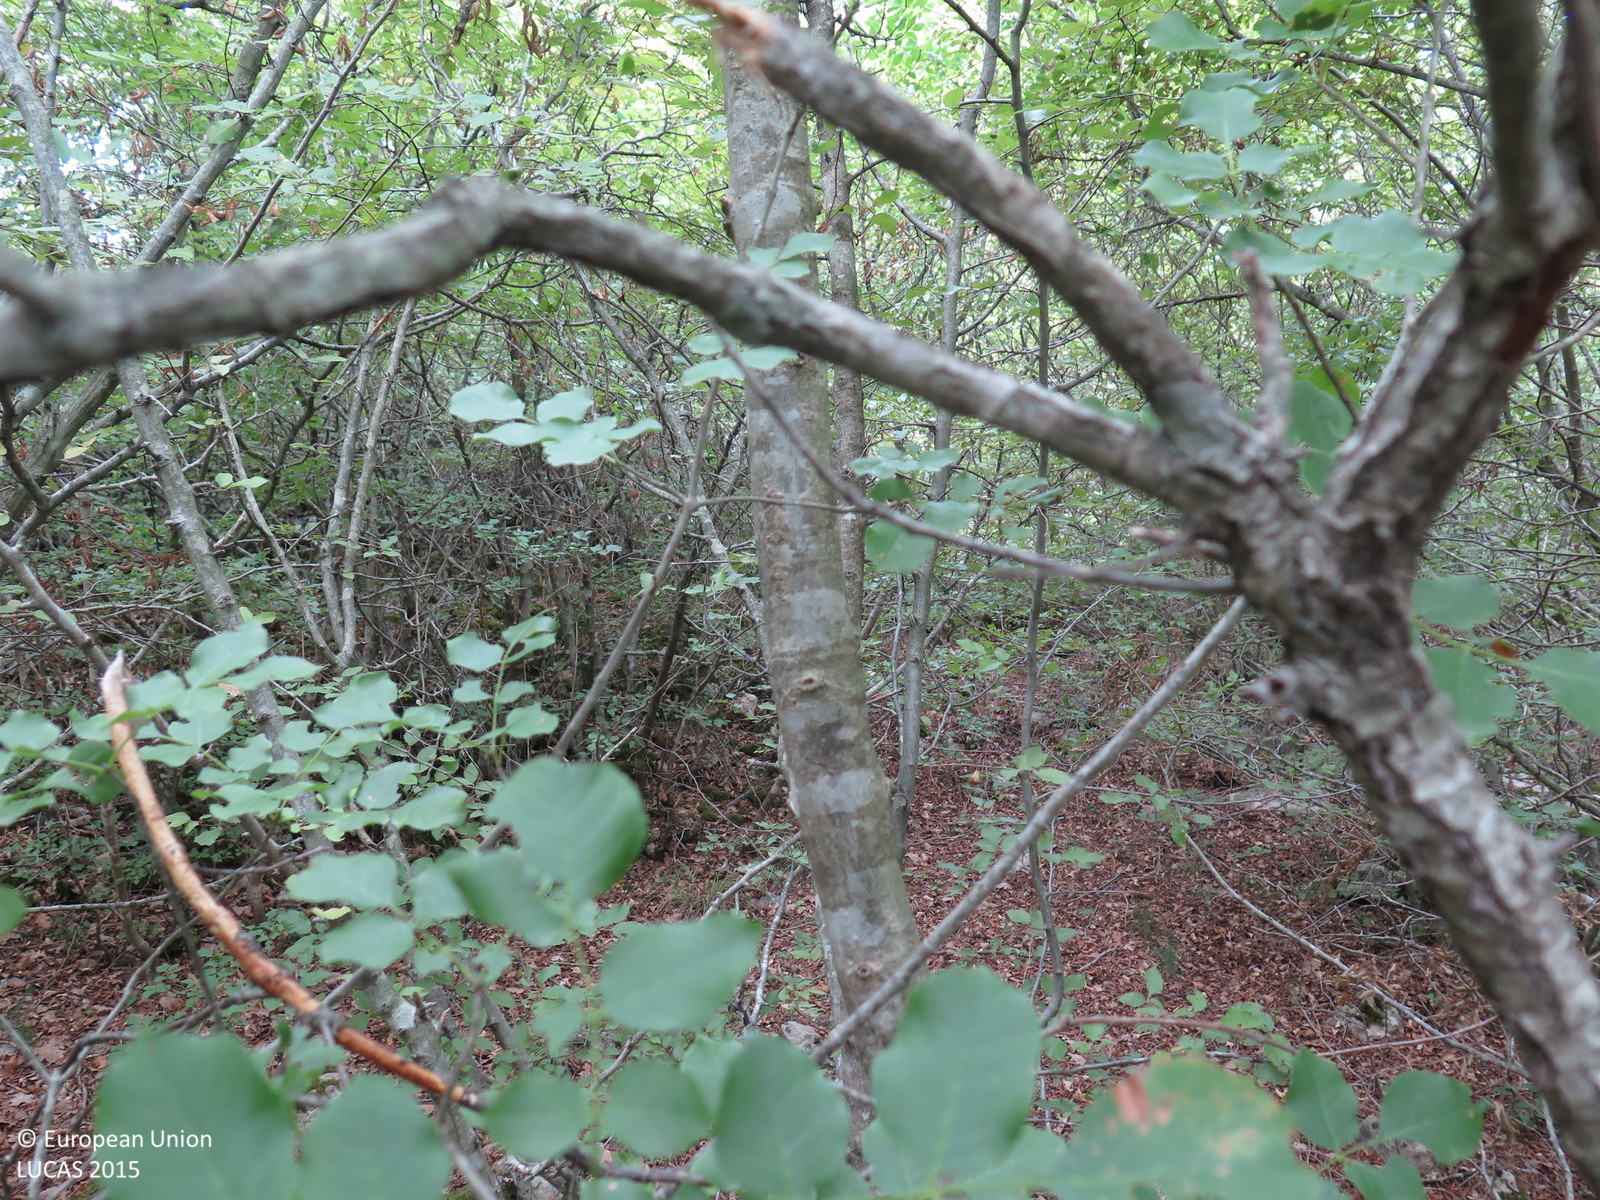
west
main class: Woodland
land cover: Broadleaved woodland
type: thermophilous deciduous forest
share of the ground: > 75 %
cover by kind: broadleaved forest trees 90 %, shrubs 5 %, herbaceous plants 5 %
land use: Semi-natural and natural areas not in use
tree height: < 5 m
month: August
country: HR
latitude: 45.0654
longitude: 14.5030
